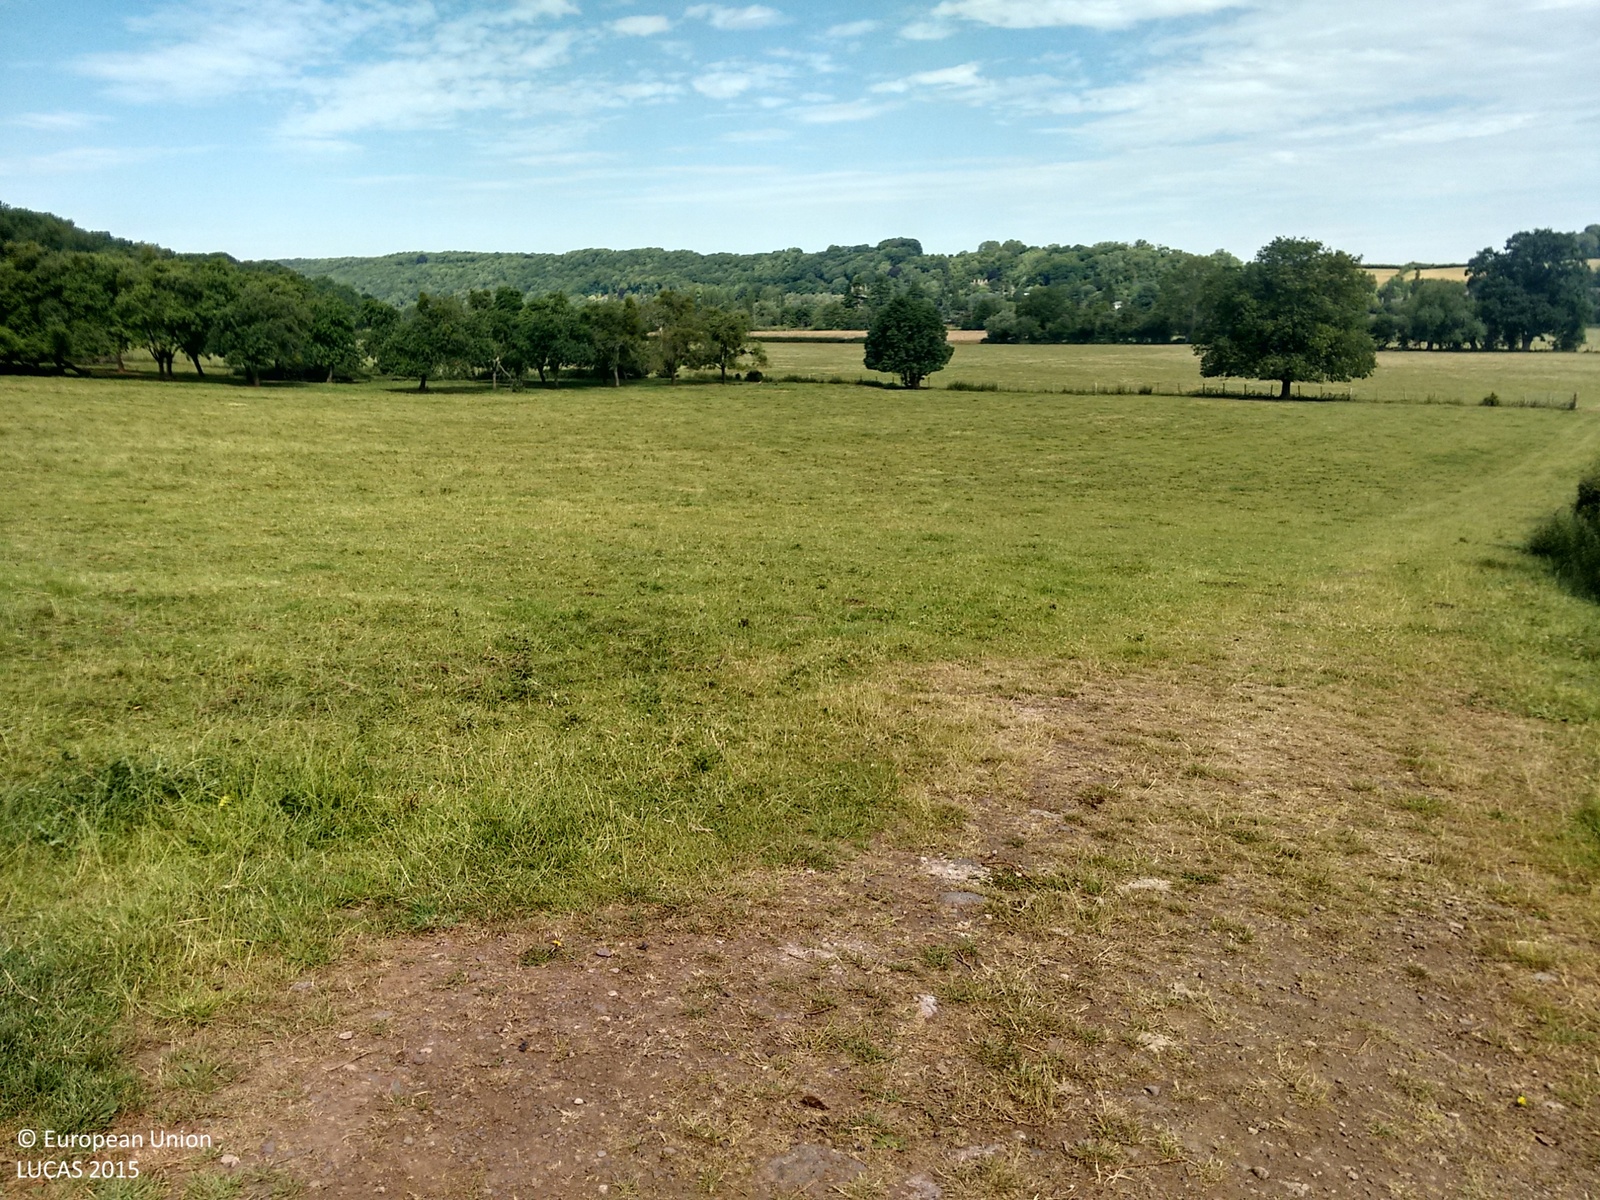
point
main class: Grassland
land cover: Grassland without tree/shrub cover
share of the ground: > 75 %
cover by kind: herbaceous plants 100 %
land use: Agriculture (excluding fallow land and kitchen gardens)
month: July
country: GB
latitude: 52.1491
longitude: -2.6818
